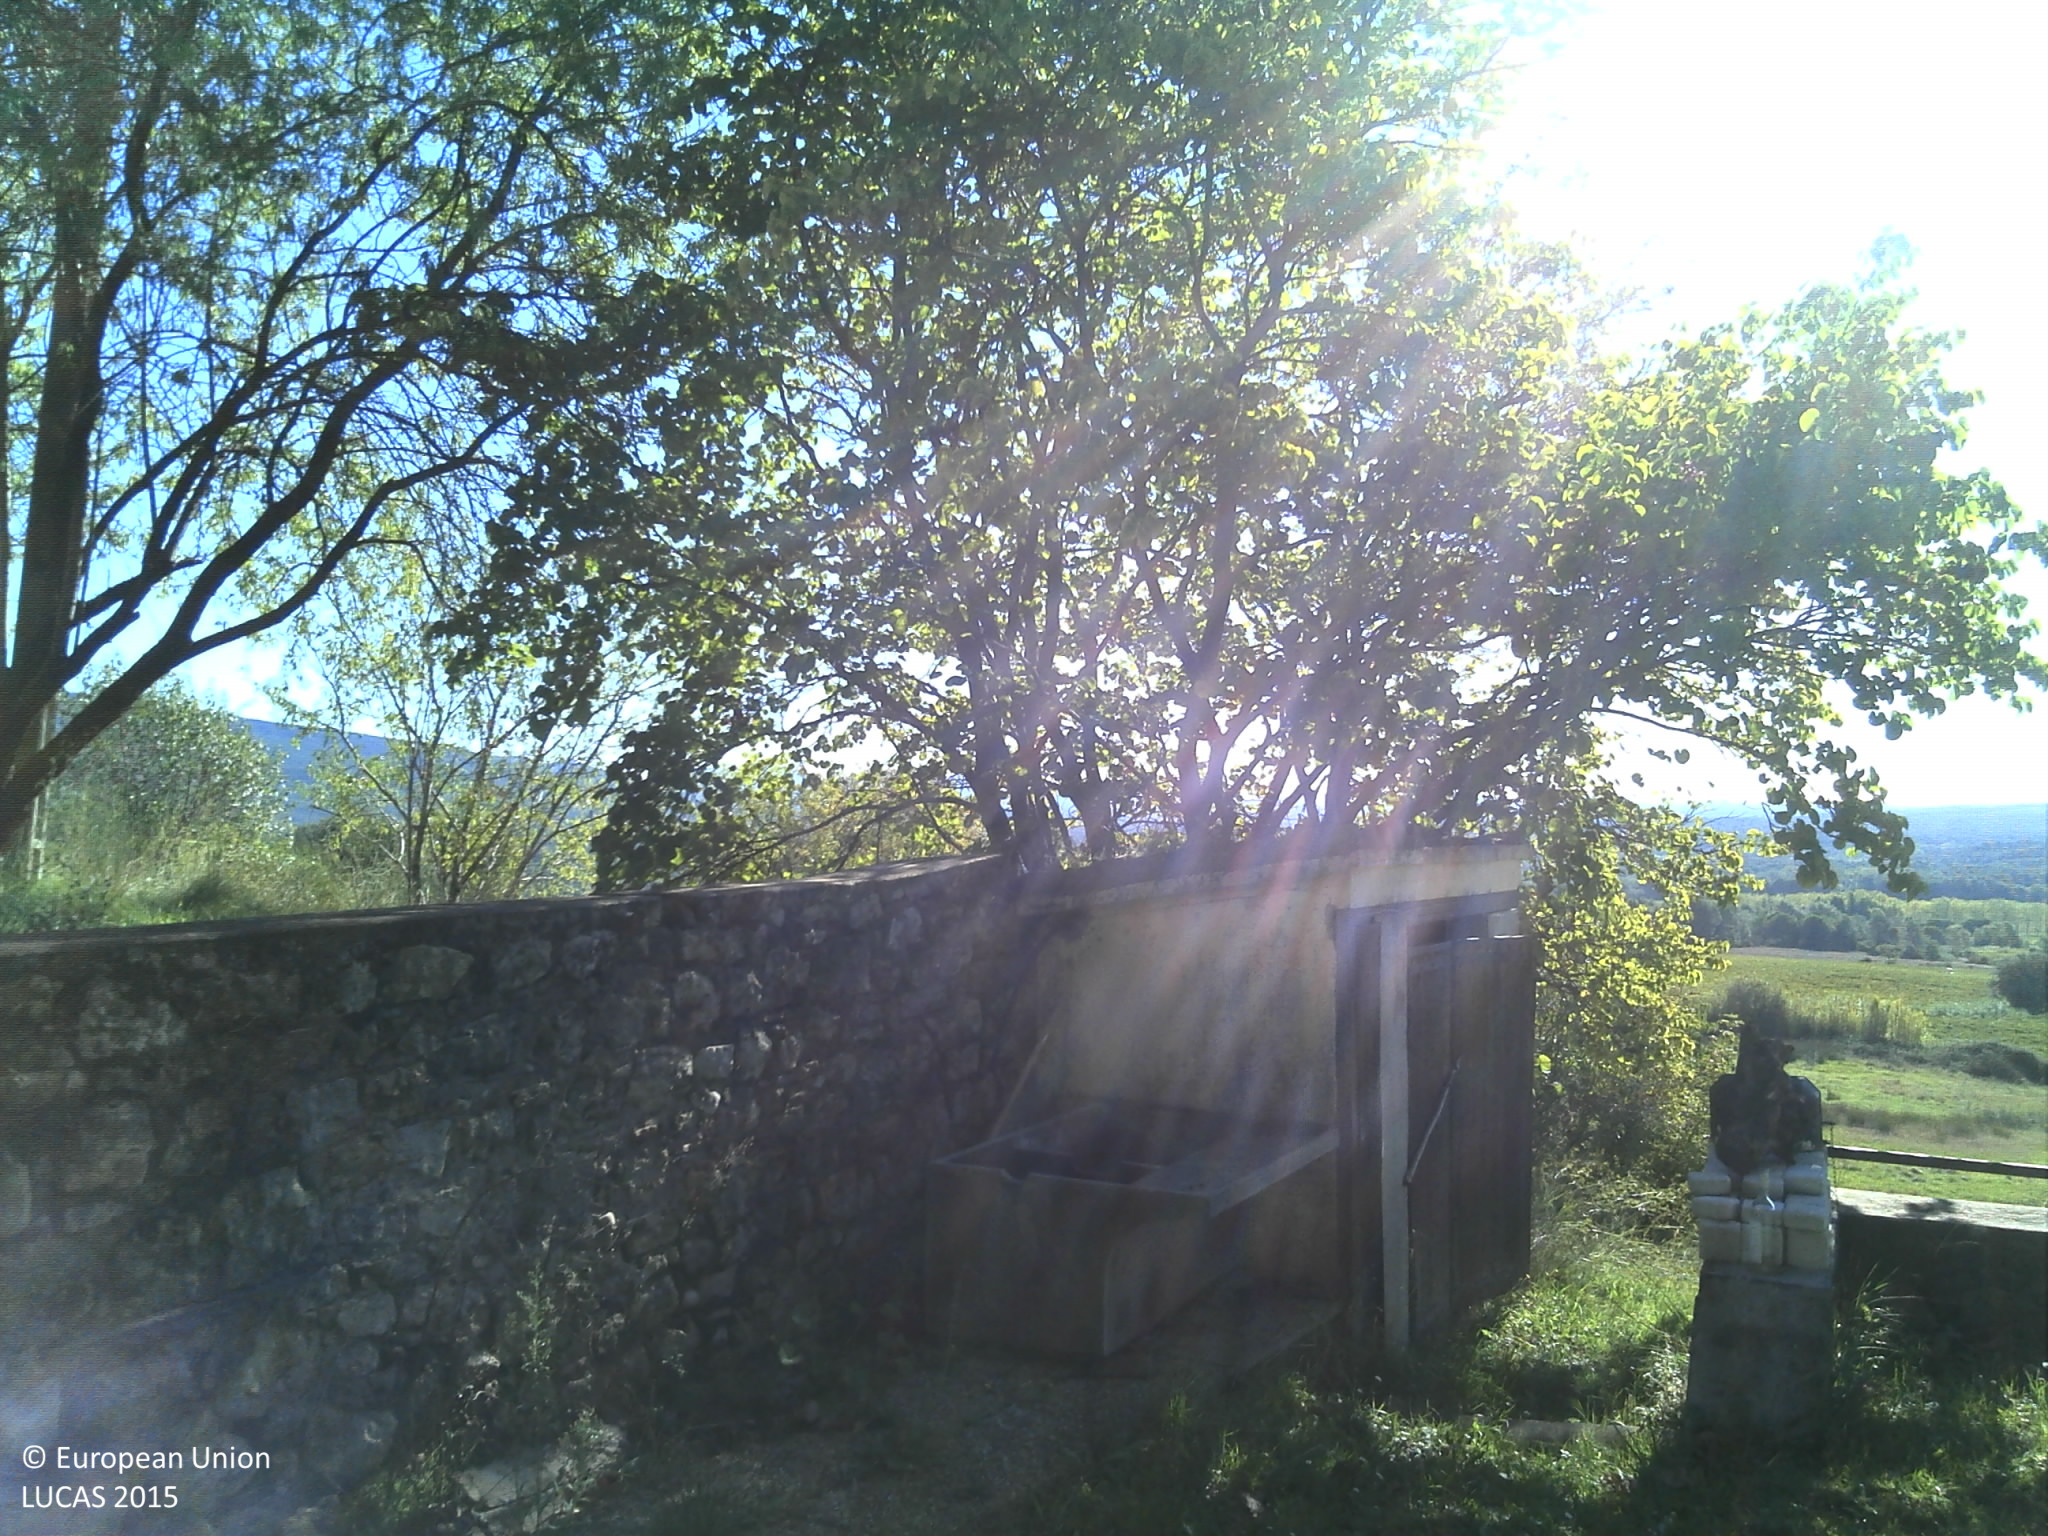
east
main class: Woodland
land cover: Broadleaved woodland
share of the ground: 50 - 75 %
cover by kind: broadleaved forest trees 50 %, herbaceous plants 50 %
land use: Residential
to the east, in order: Broadleaved woodland; Artificial constructions in urban areas; Broadleaved woodland; Grassland without tree/shrub cover; Electric lines; Grassland without tree/shrub cover; Managed hedges; Grassland without tree/shrub cover; Single bushes/trees; Tracks; Vineyards; Electric lines; Tracks; Vineyards
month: October
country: FR
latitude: 43.5170
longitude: 6.5569
